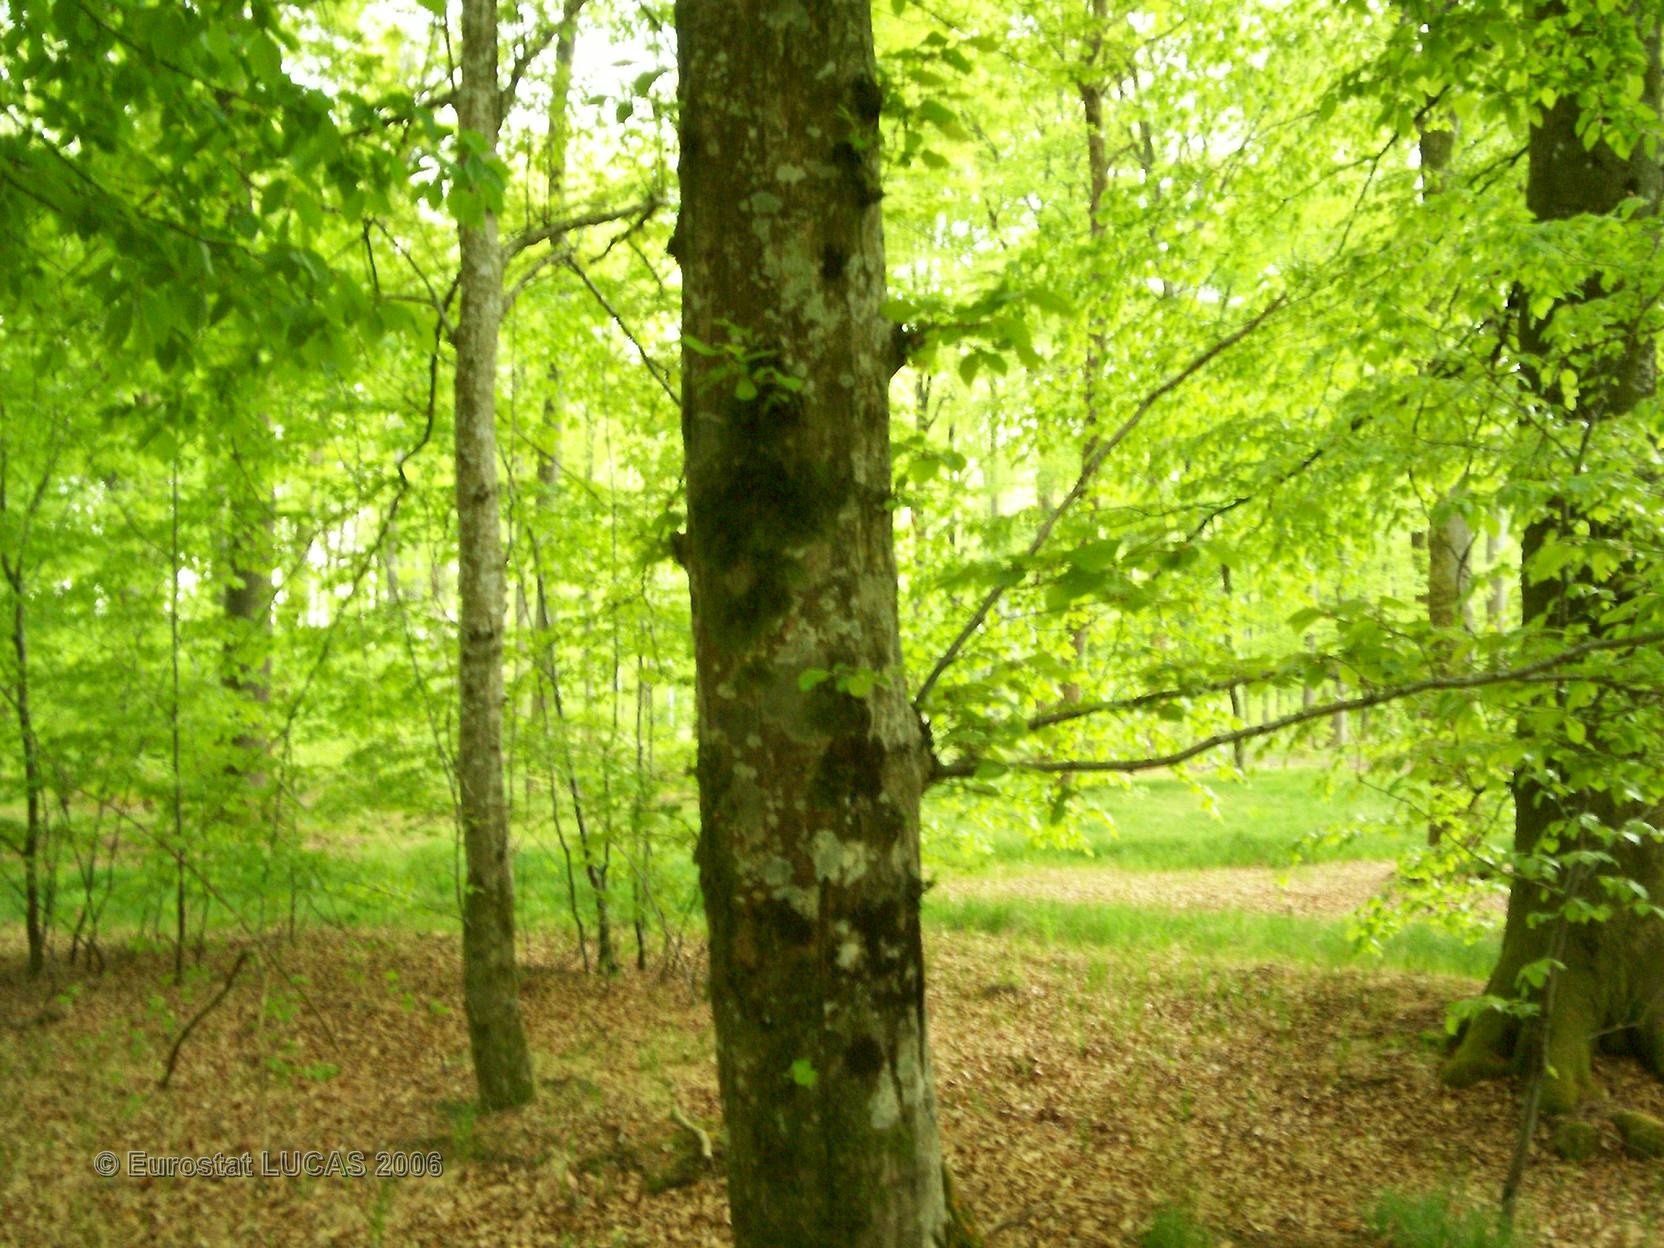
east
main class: Woodland
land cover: Broadleaved forest
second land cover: Grassland with sparse tree/shrub cover
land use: Forestry
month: May
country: FR
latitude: 47.7354
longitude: 7.1078
